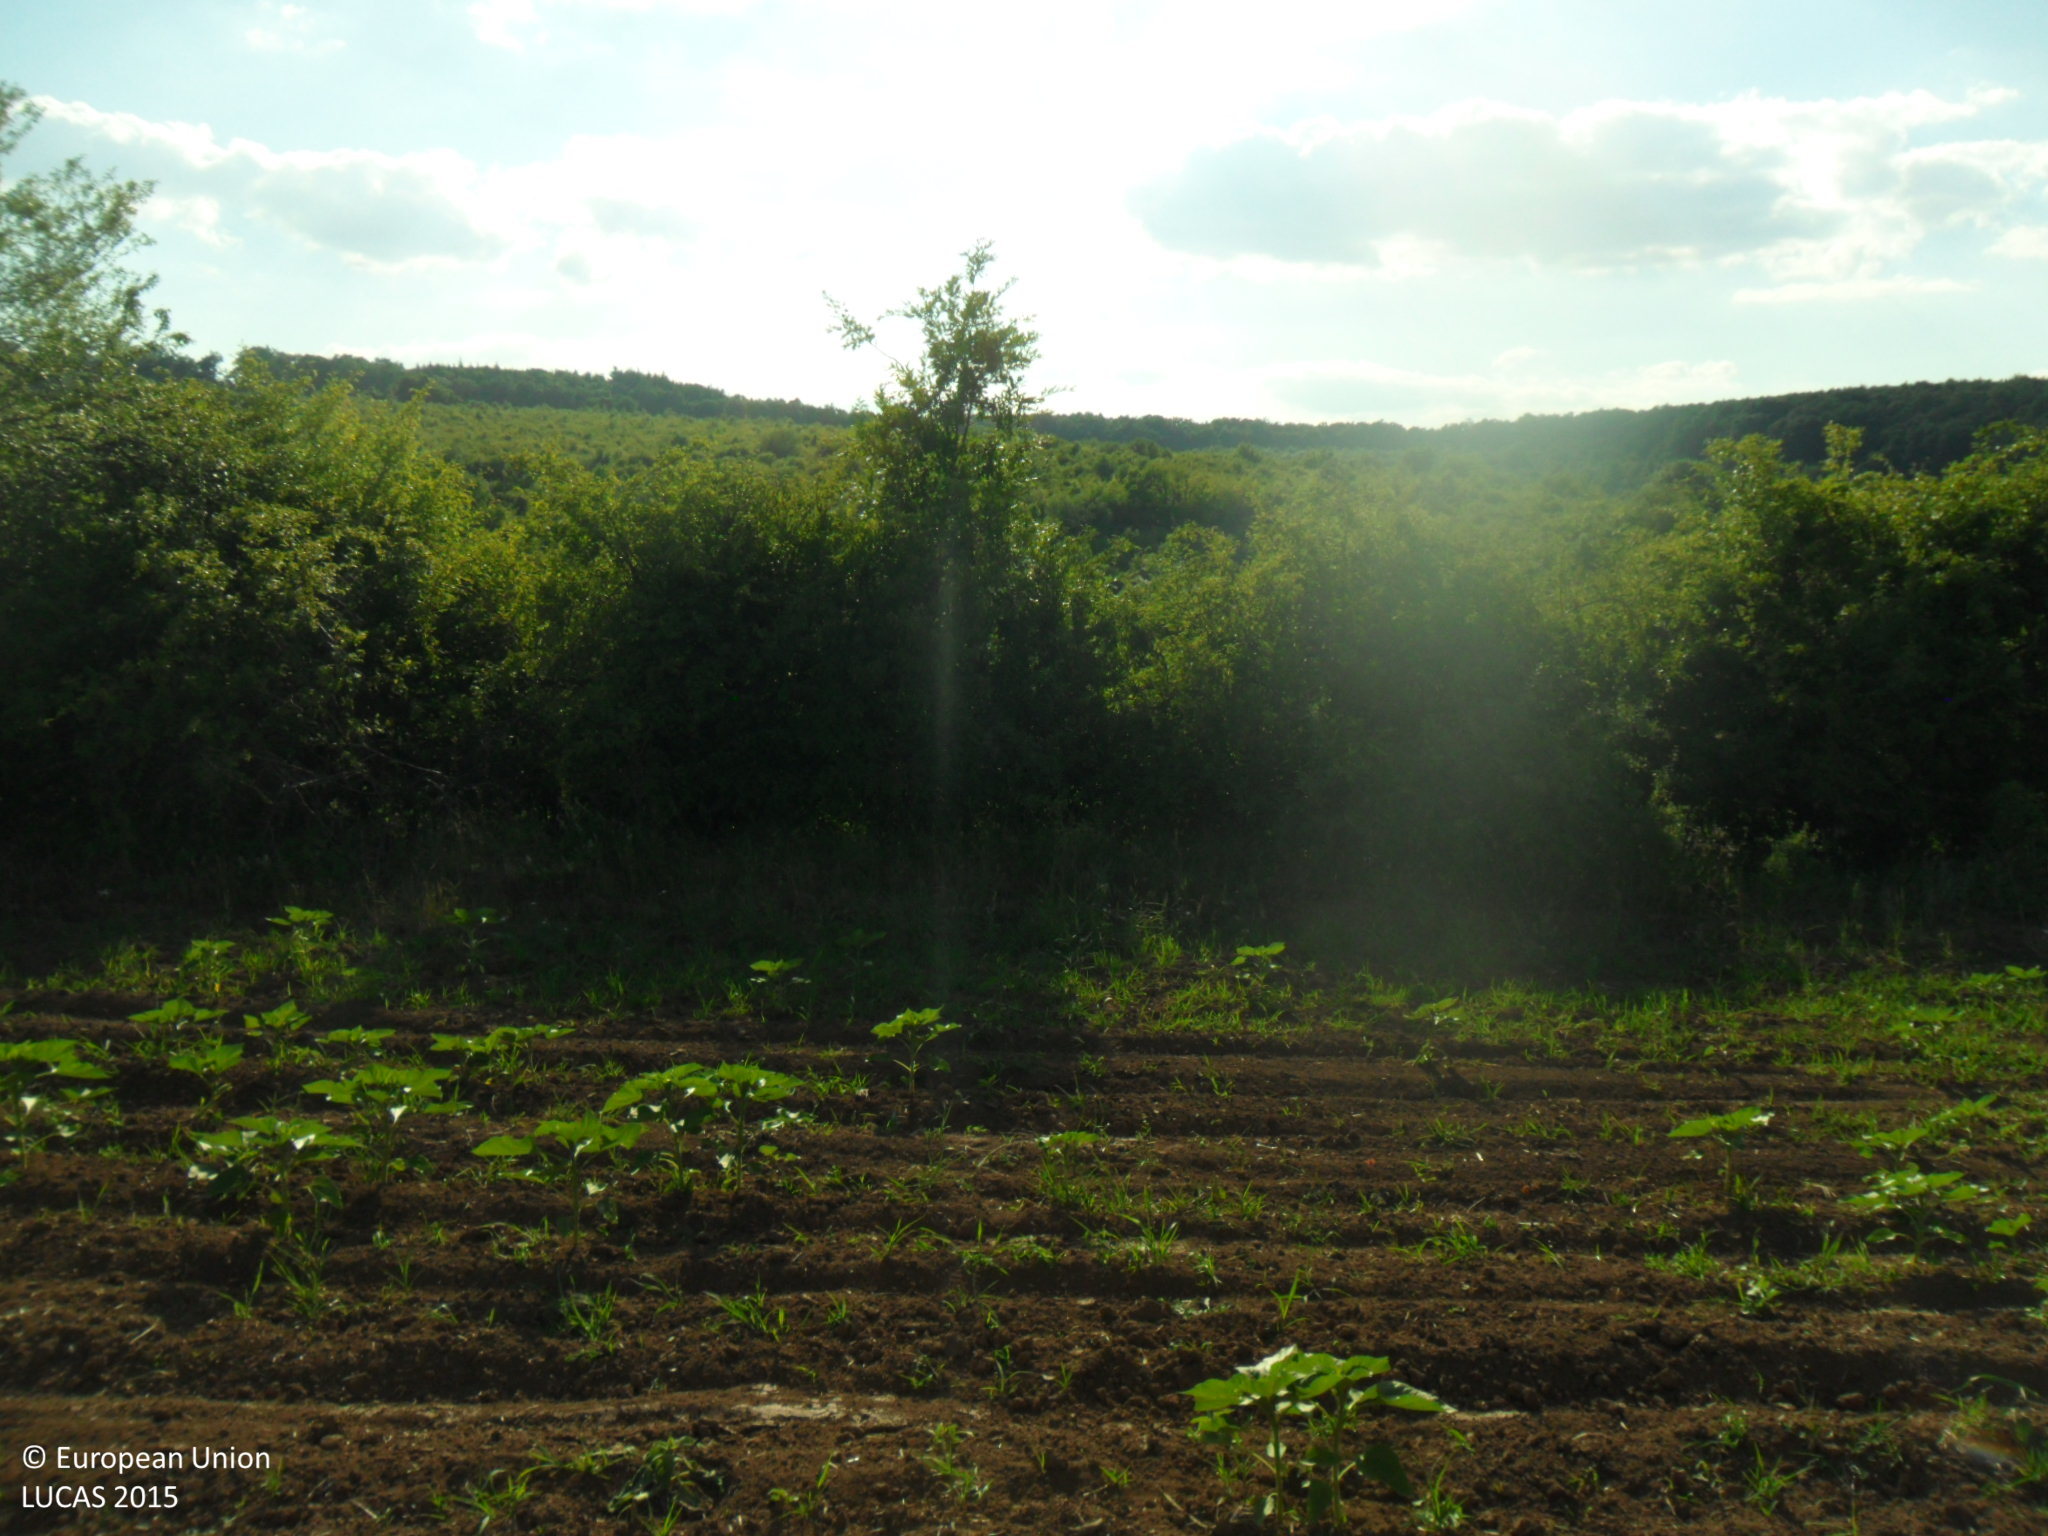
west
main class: Cropland
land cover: Sunflower
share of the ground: 50 - 75 %
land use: Agriculture (excluding fallow land and kitchen gardens)
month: June
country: BG
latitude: 43.5083
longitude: 26.8744
